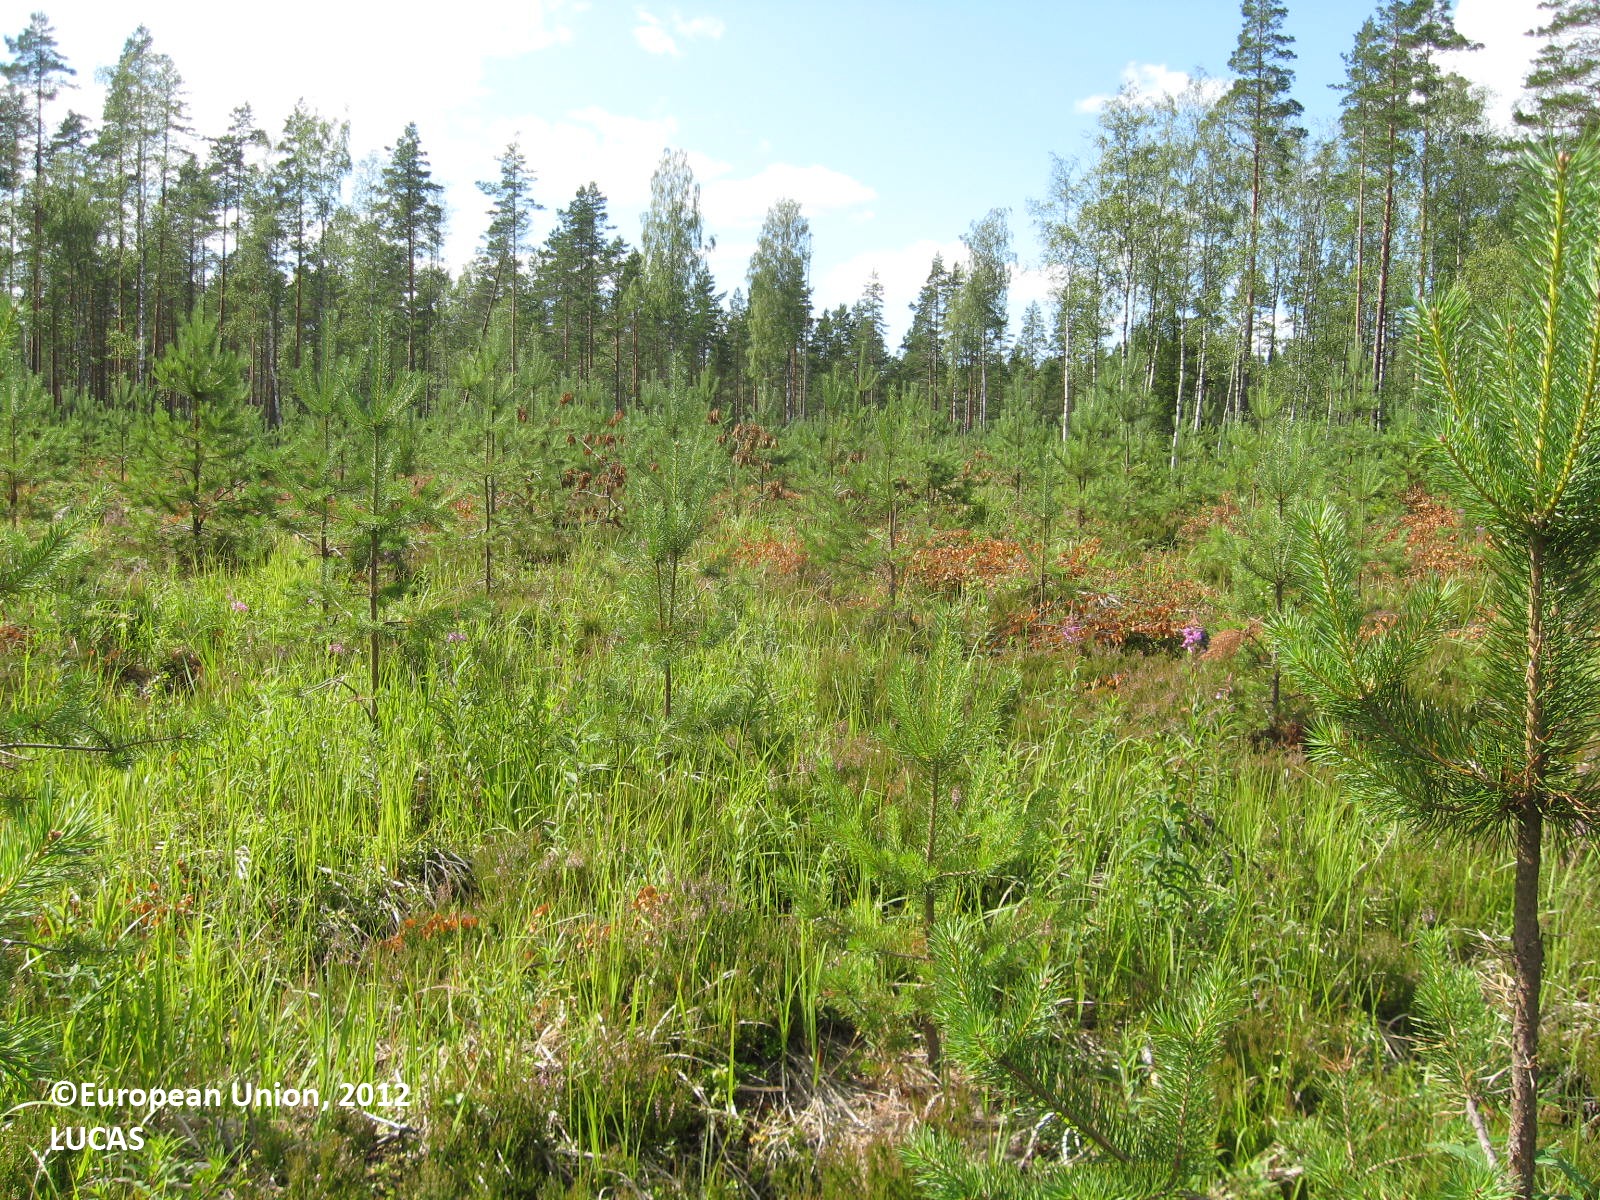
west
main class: Woodland
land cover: Pine dominated coniferous woodland
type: boreal forest
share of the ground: 25 - 50 %
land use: Forestry
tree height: < 5 m
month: July
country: FI
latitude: 62.0002
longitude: 22.6834
